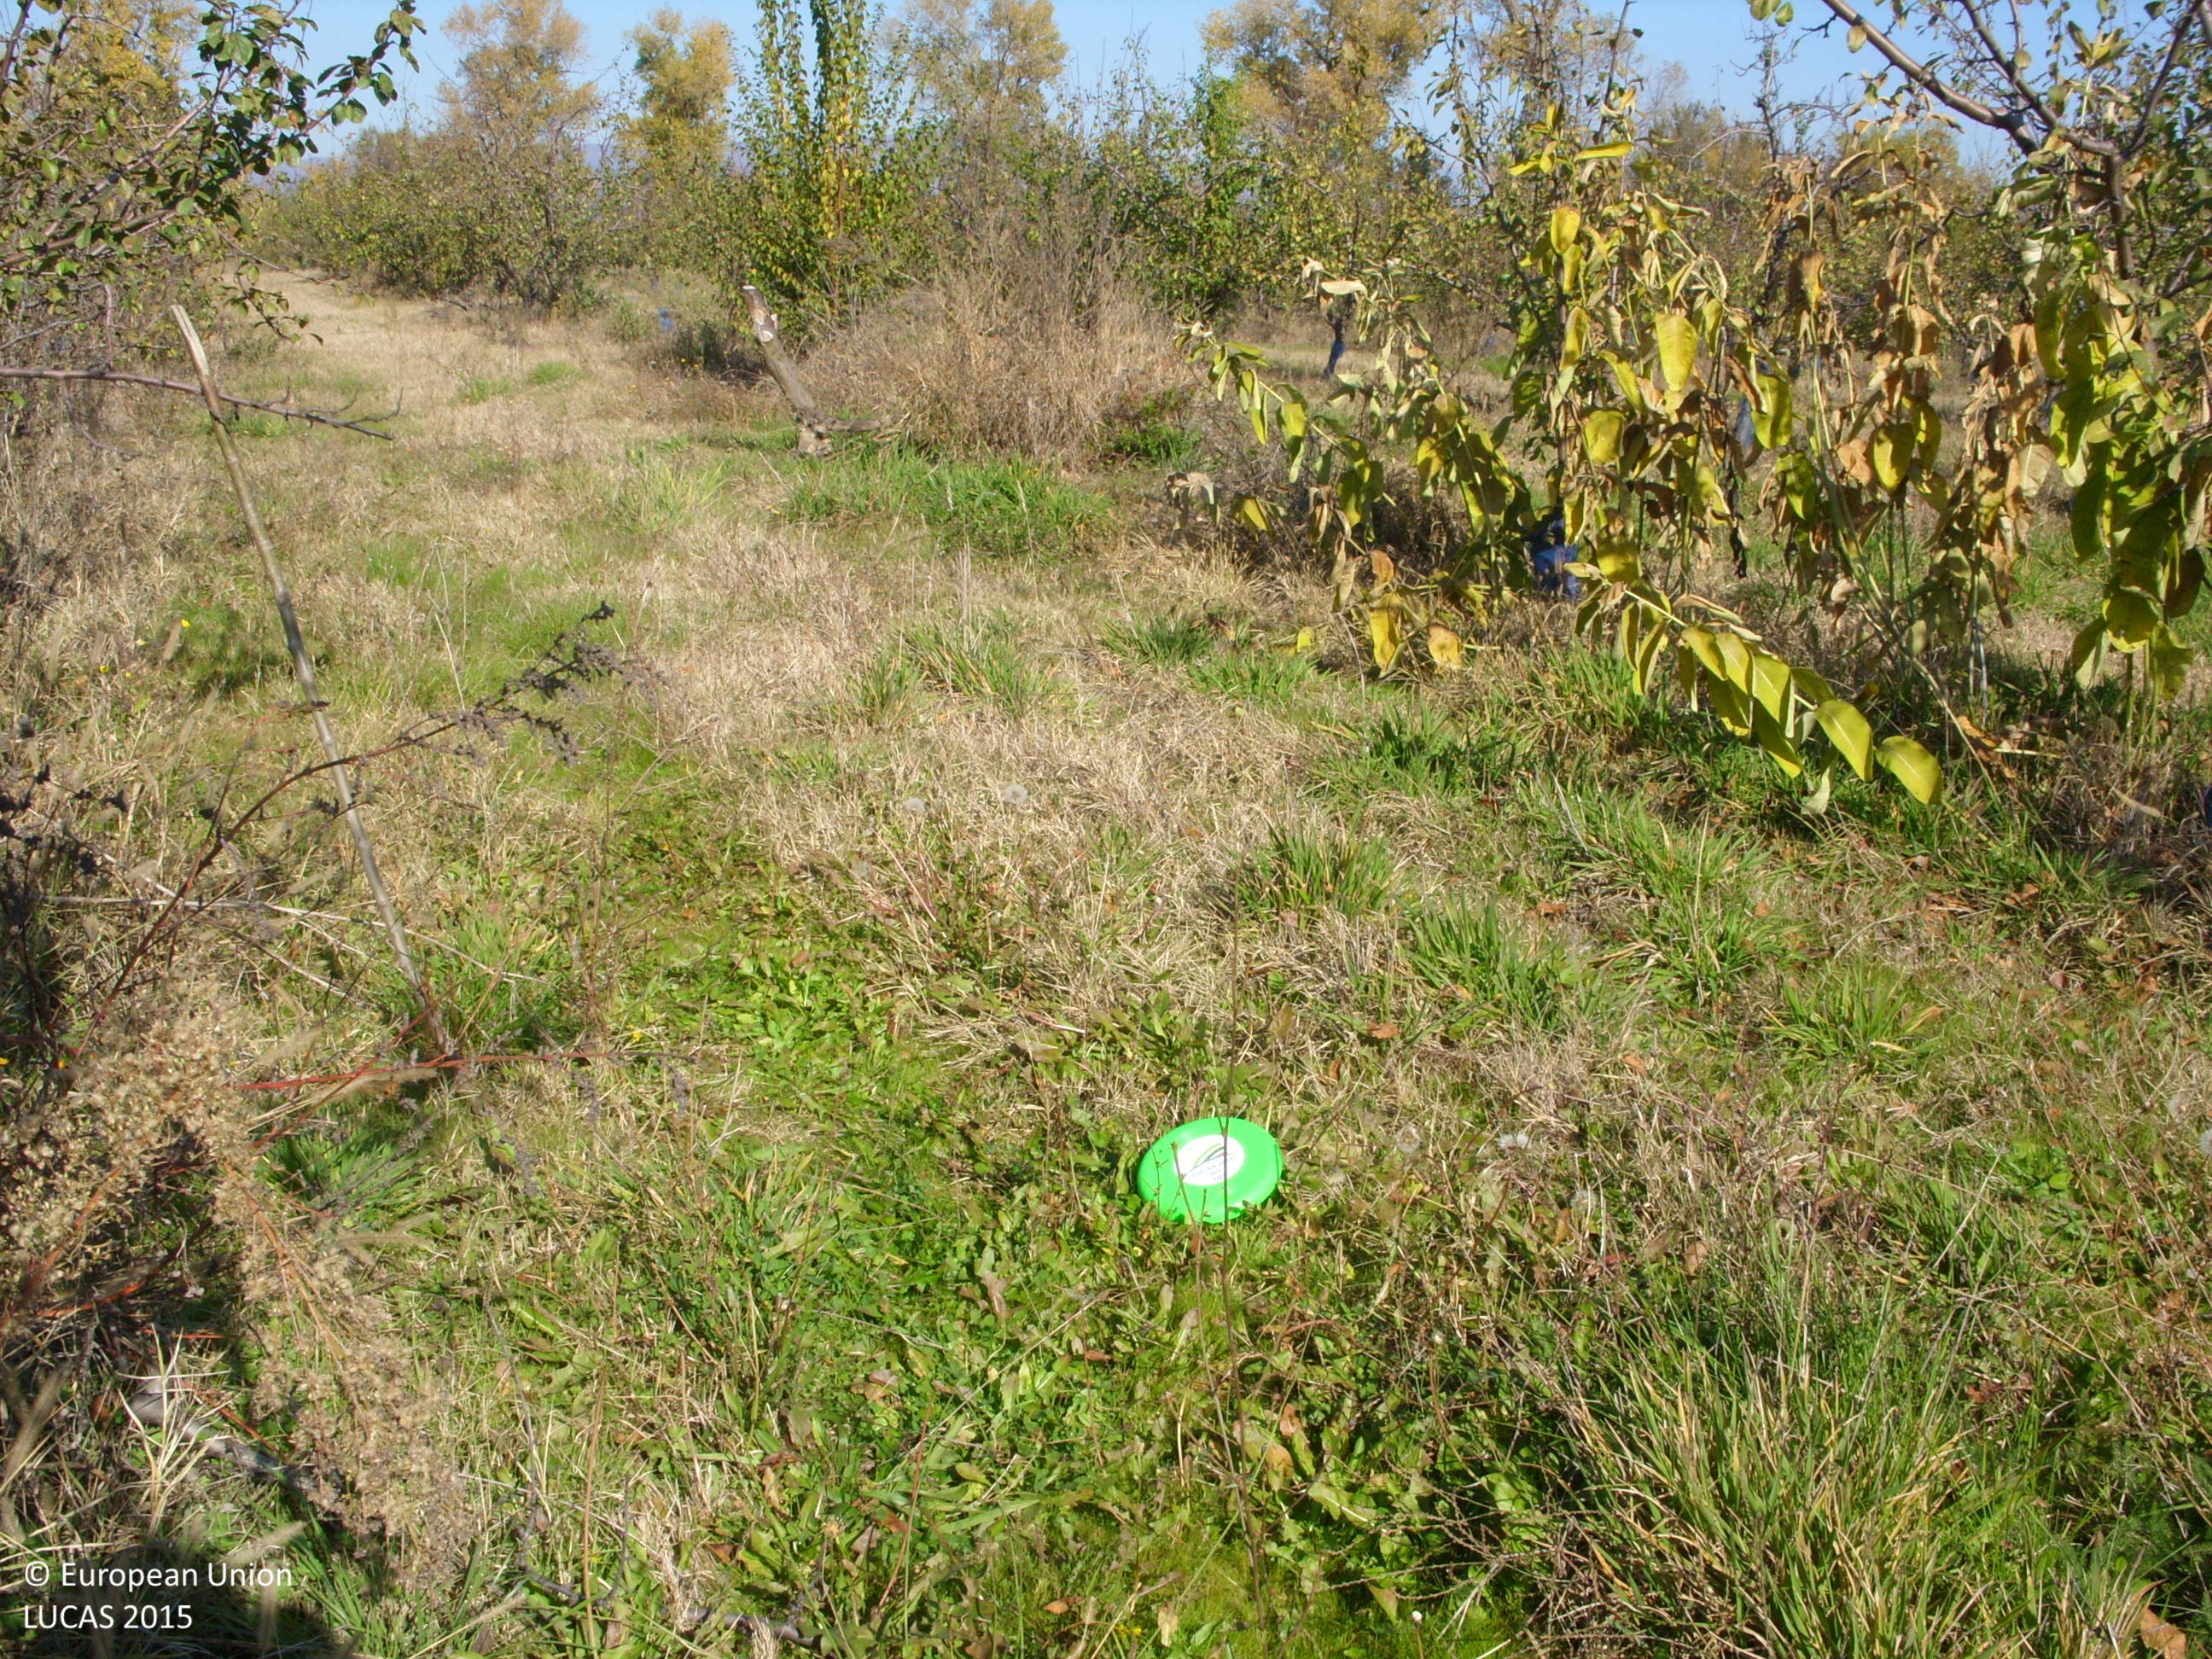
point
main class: Cropland
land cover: Other fruit trees and berries
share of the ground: 10 - 25 %
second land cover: Spontaneously vegetated surfaces
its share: > 75 %
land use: Agriculture (excluding fallow land and kitchen gardens)
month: November
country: BG
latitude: 42.4569
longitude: 24.6825
